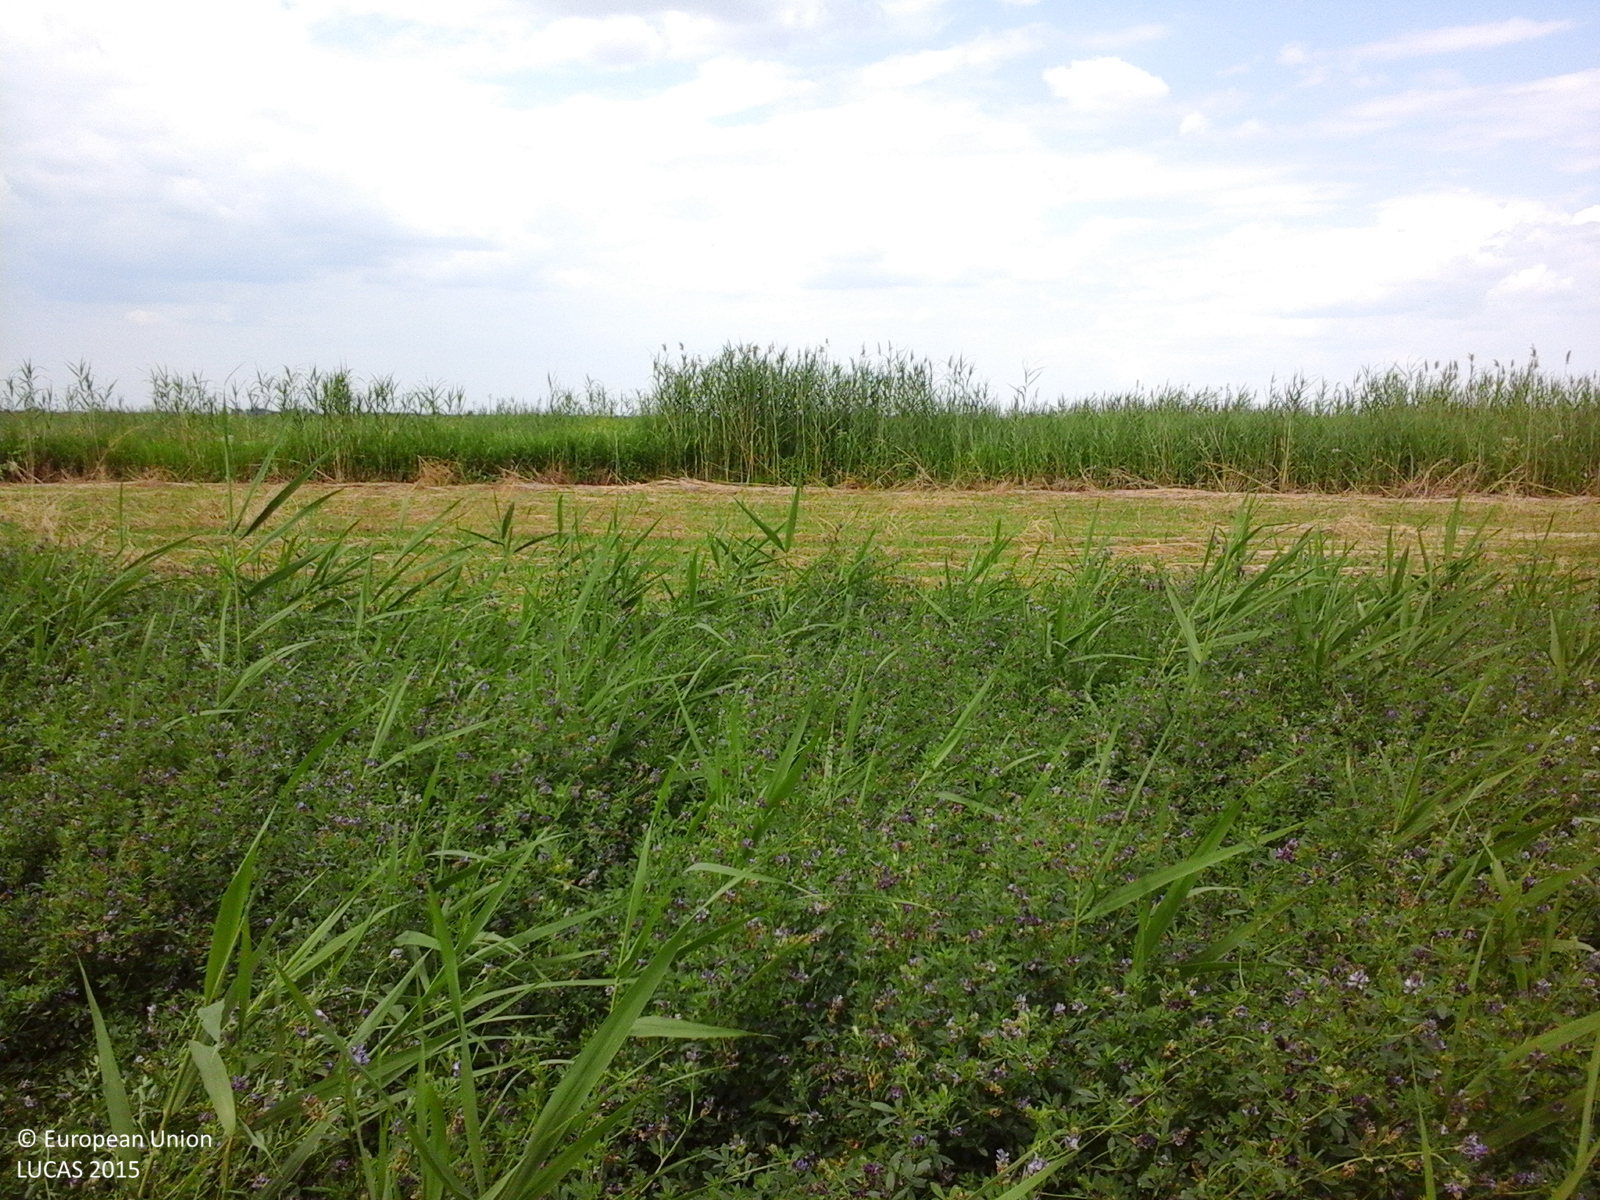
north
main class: Cropland
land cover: Lucerne
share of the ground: > 75 %
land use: Agriculture (excluding fallow land and kitchen gardens)
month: June
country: RO
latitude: 44.2220
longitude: 26.2159
